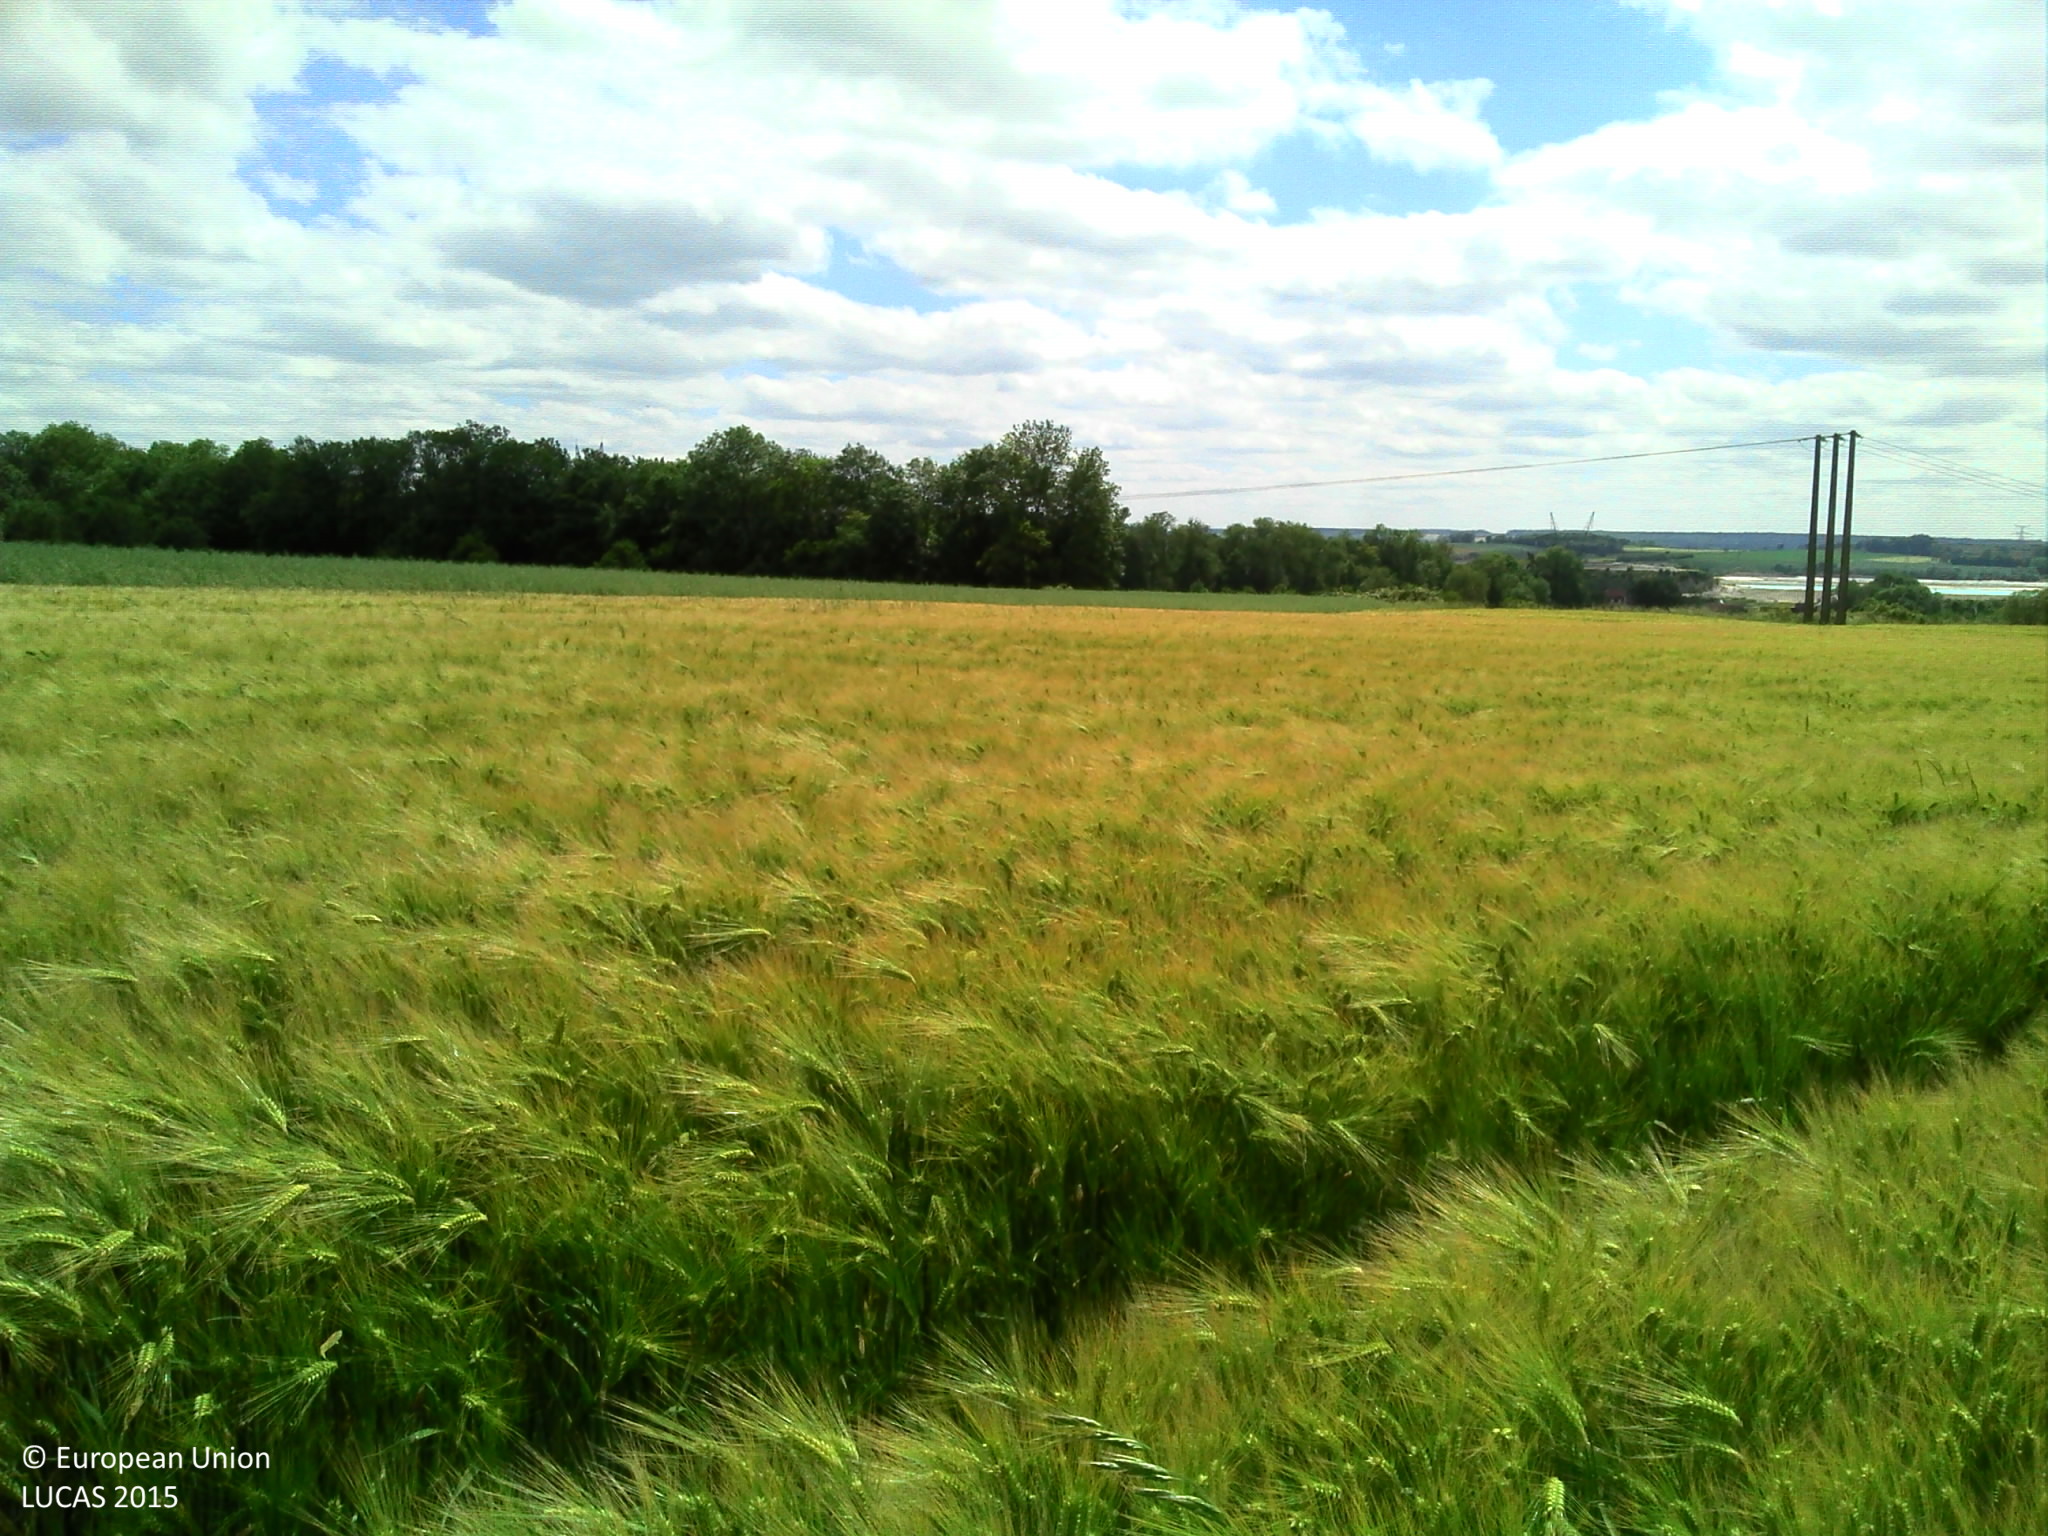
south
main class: Cropland
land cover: Barley
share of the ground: > 75 %
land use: Agriculture (excluding fallow land and kitchen gardens)
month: June
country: FR
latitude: 48.6647
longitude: 6.2662
